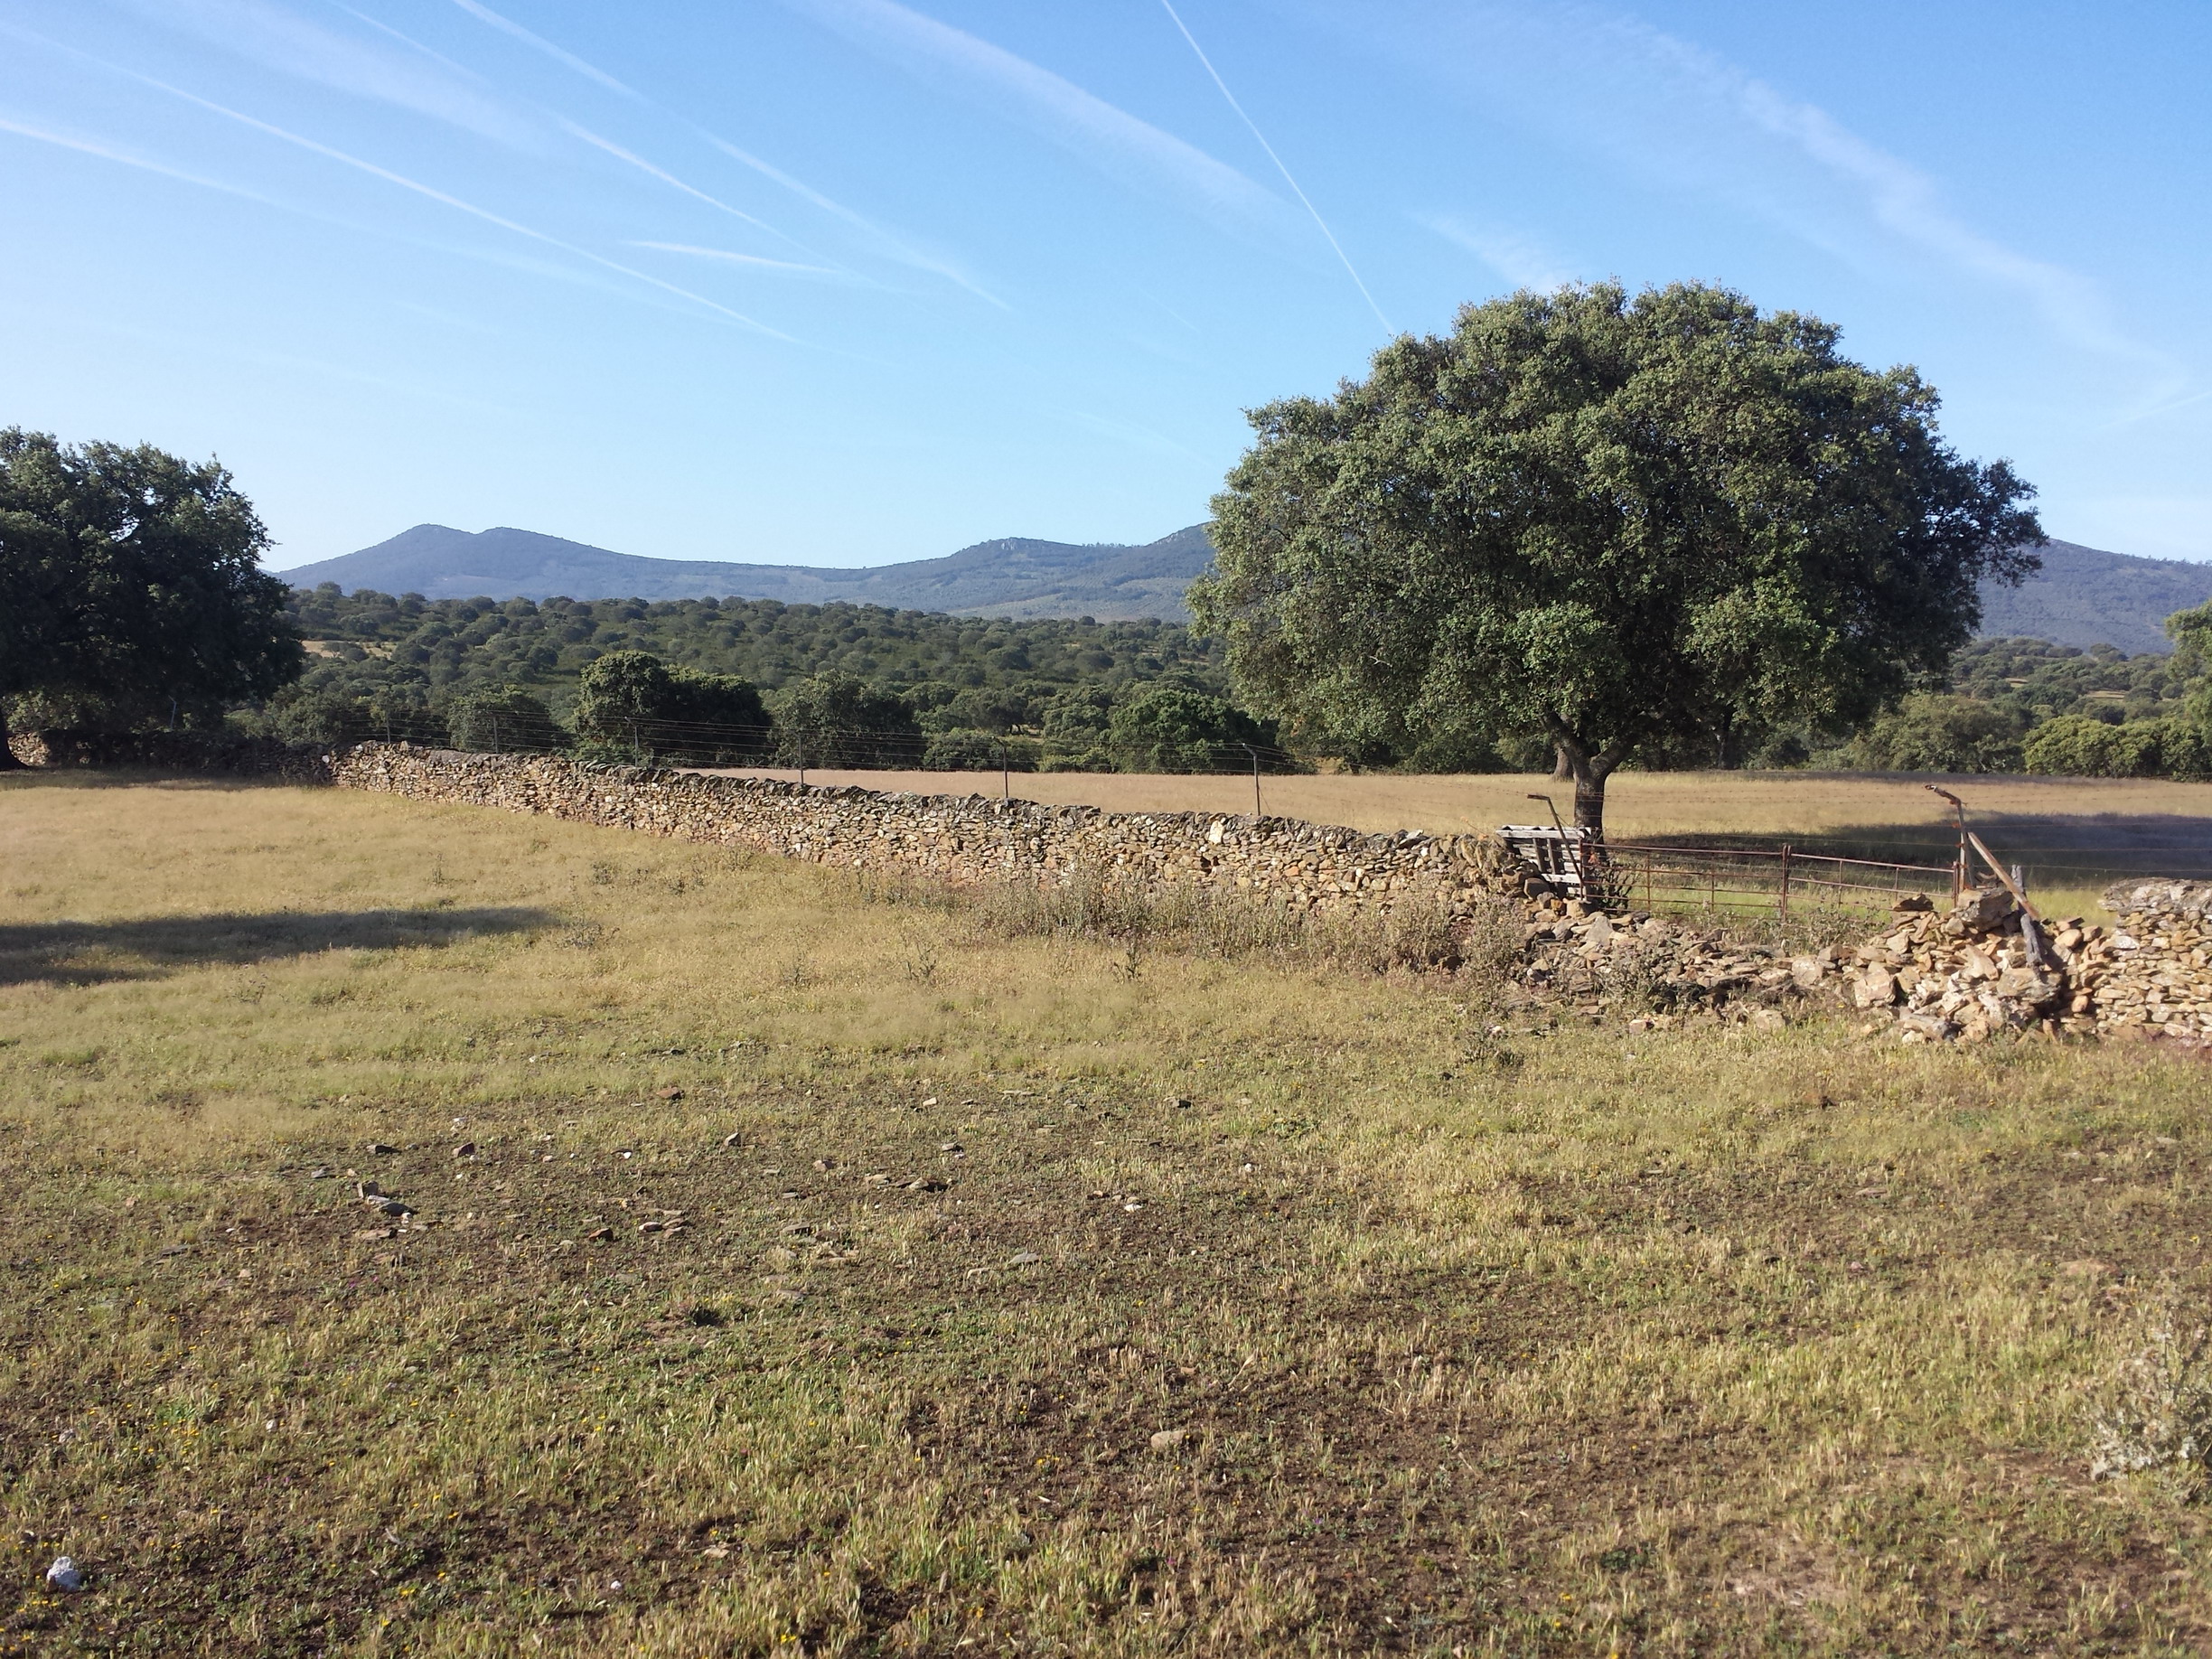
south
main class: Grassland
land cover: Grassland with sparse tree/shrub cover
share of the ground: > 75 %
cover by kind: herbaceous plants 90 %, broadleaved forest trees 5 %
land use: Agriculture (excluding fallow land and kitchen gardens)
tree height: > 5 m
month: May
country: ES
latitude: 39.6384
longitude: -7.2058
